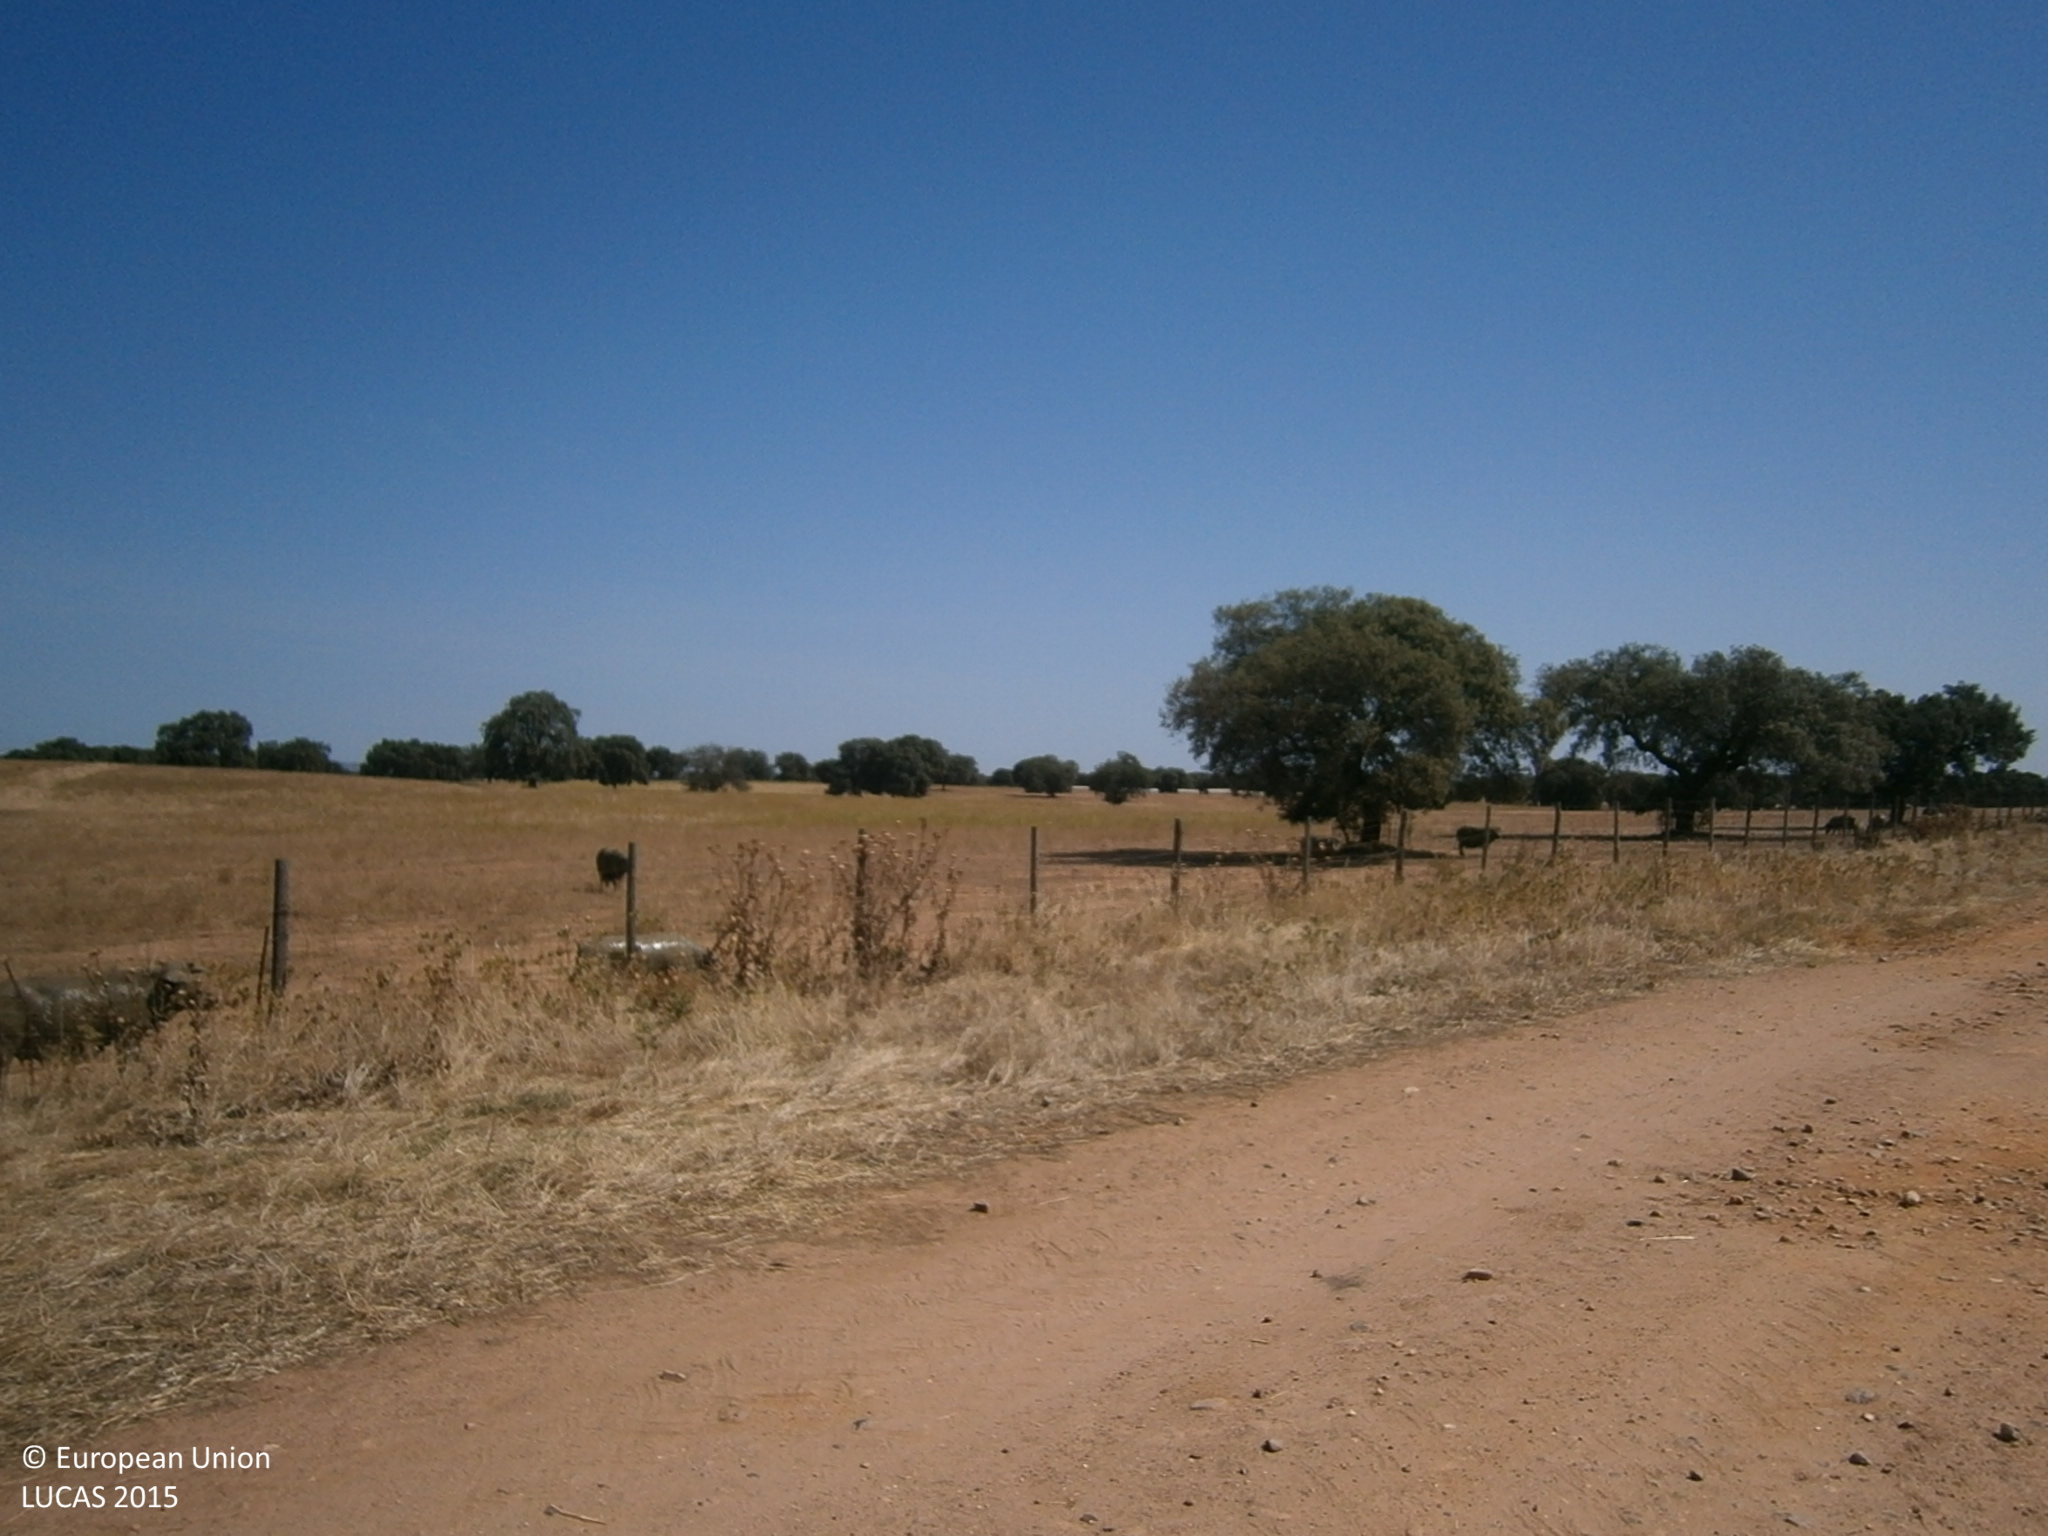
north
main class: Cropland
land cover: Durum wheat
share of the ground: > 75 %
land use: Agriculture (excluding fallow land and kitchen gardens)
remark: Harvested field
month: July
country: ES
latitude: 39.0094
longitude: -6.8020
